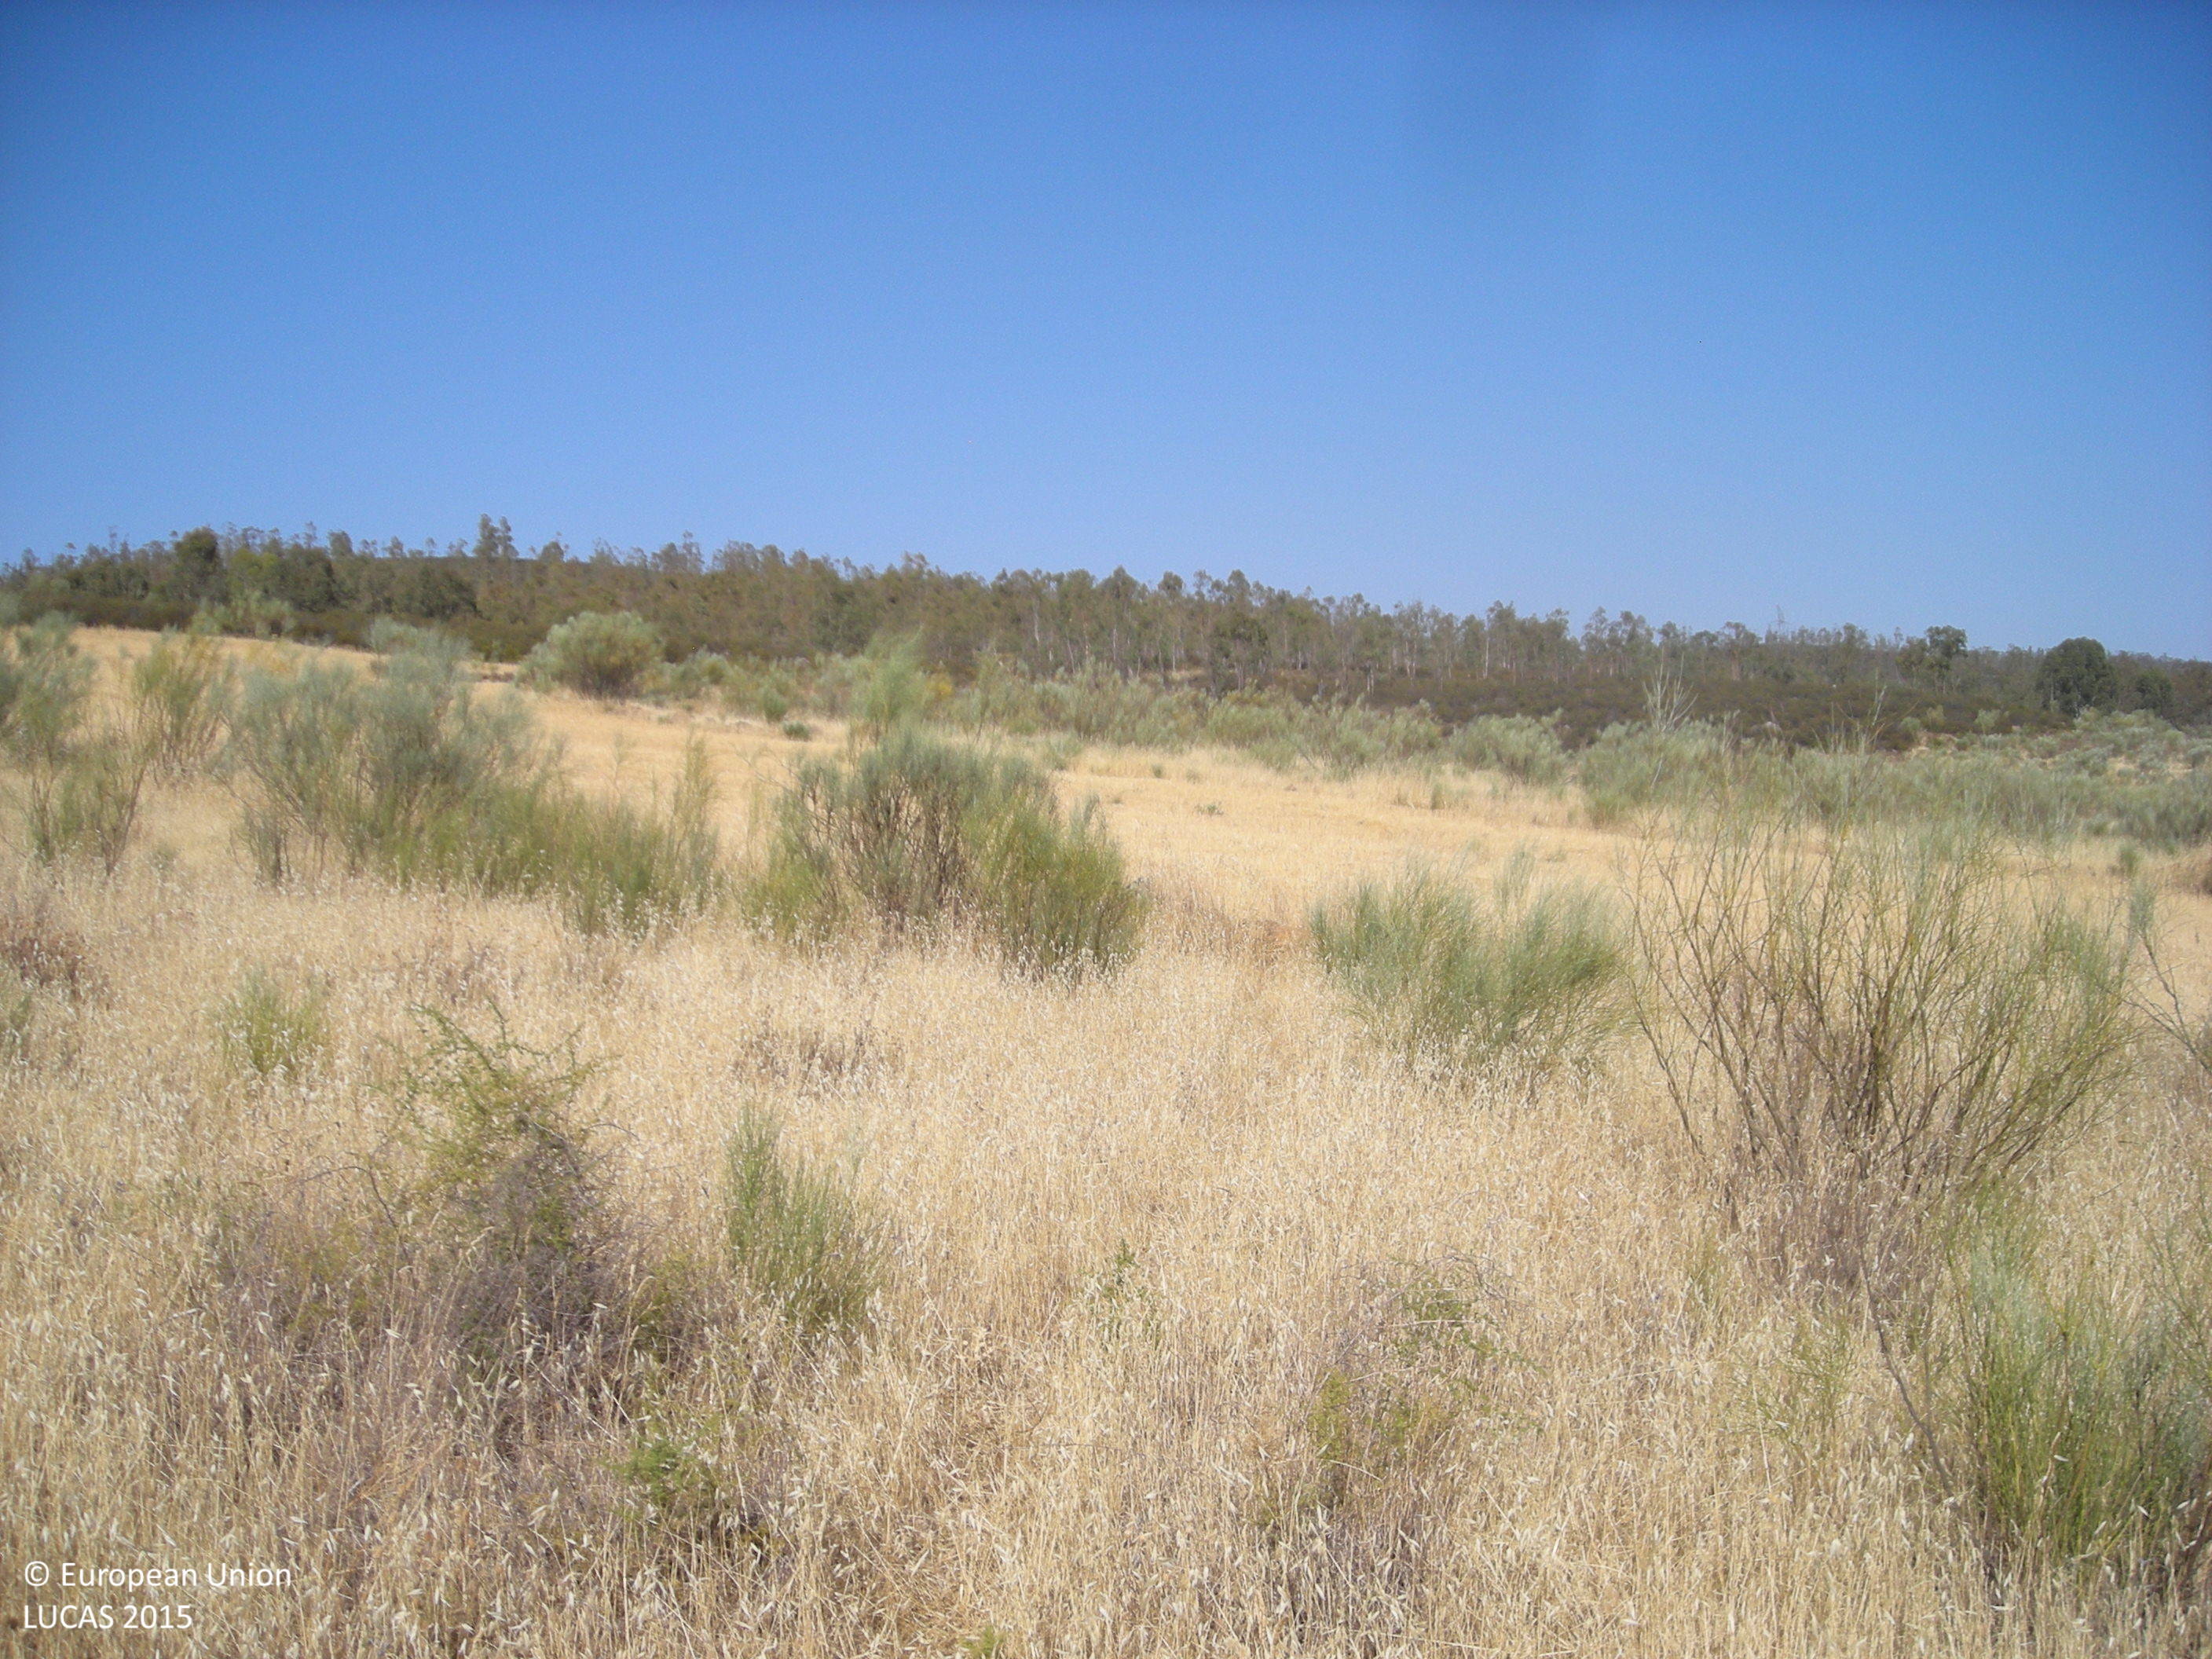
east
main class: Shrubland
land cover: Shrubland without tree cover
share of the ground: > 75 %
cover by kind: shrubs 100 %
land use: Agriculture (excluding fallow land and kitchen gardens)
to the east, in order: Shrubland without tree cover; Oats; Shrubland without tree cover; Grassland without tree/shrub cover; Shrubland without tree cover
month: July
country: ES
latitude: 38.6903
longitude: -5.7590
